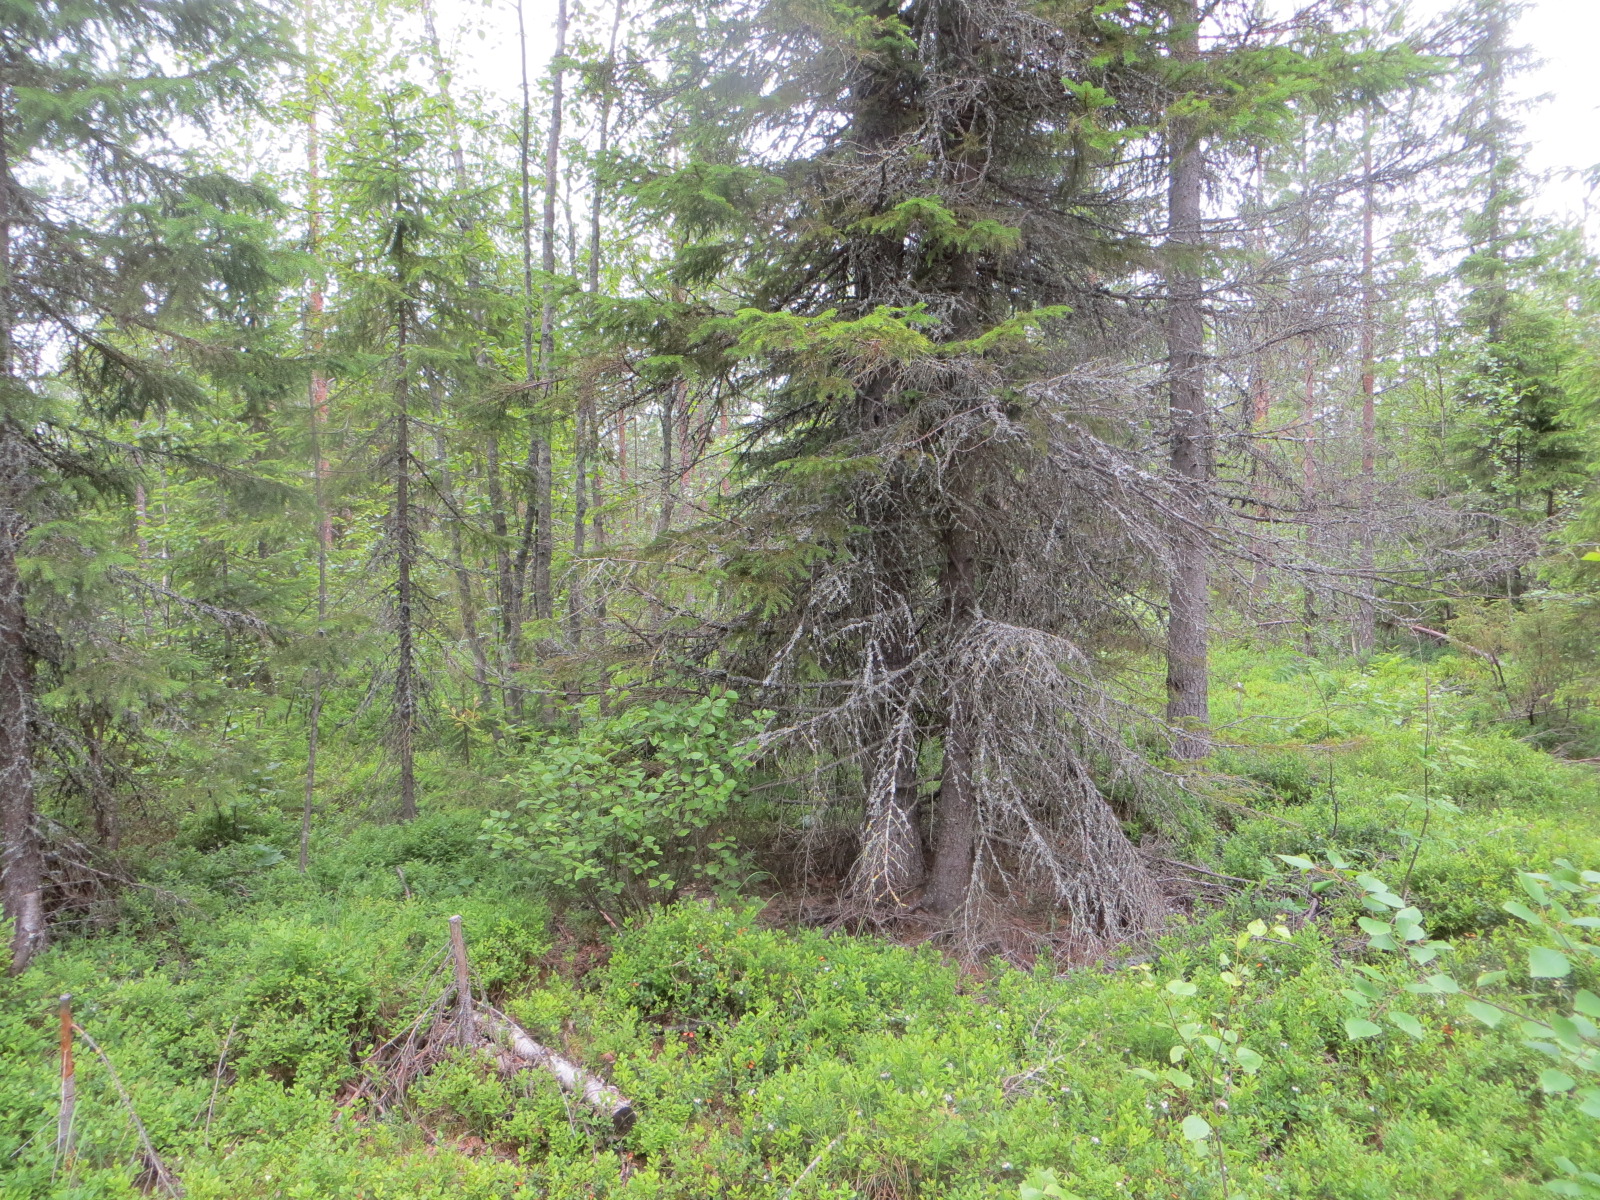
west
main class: Woodland
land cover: Other mixed woodland
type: boreal forest
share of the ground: 50 - 75 %
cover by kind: coniferous forest trees 40 %, broadleaved forest trees 30 %, shrubs 30 %
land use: Forestry
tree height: > 5 m
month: July
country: FI
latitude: 65.7554
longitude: 25.3258
